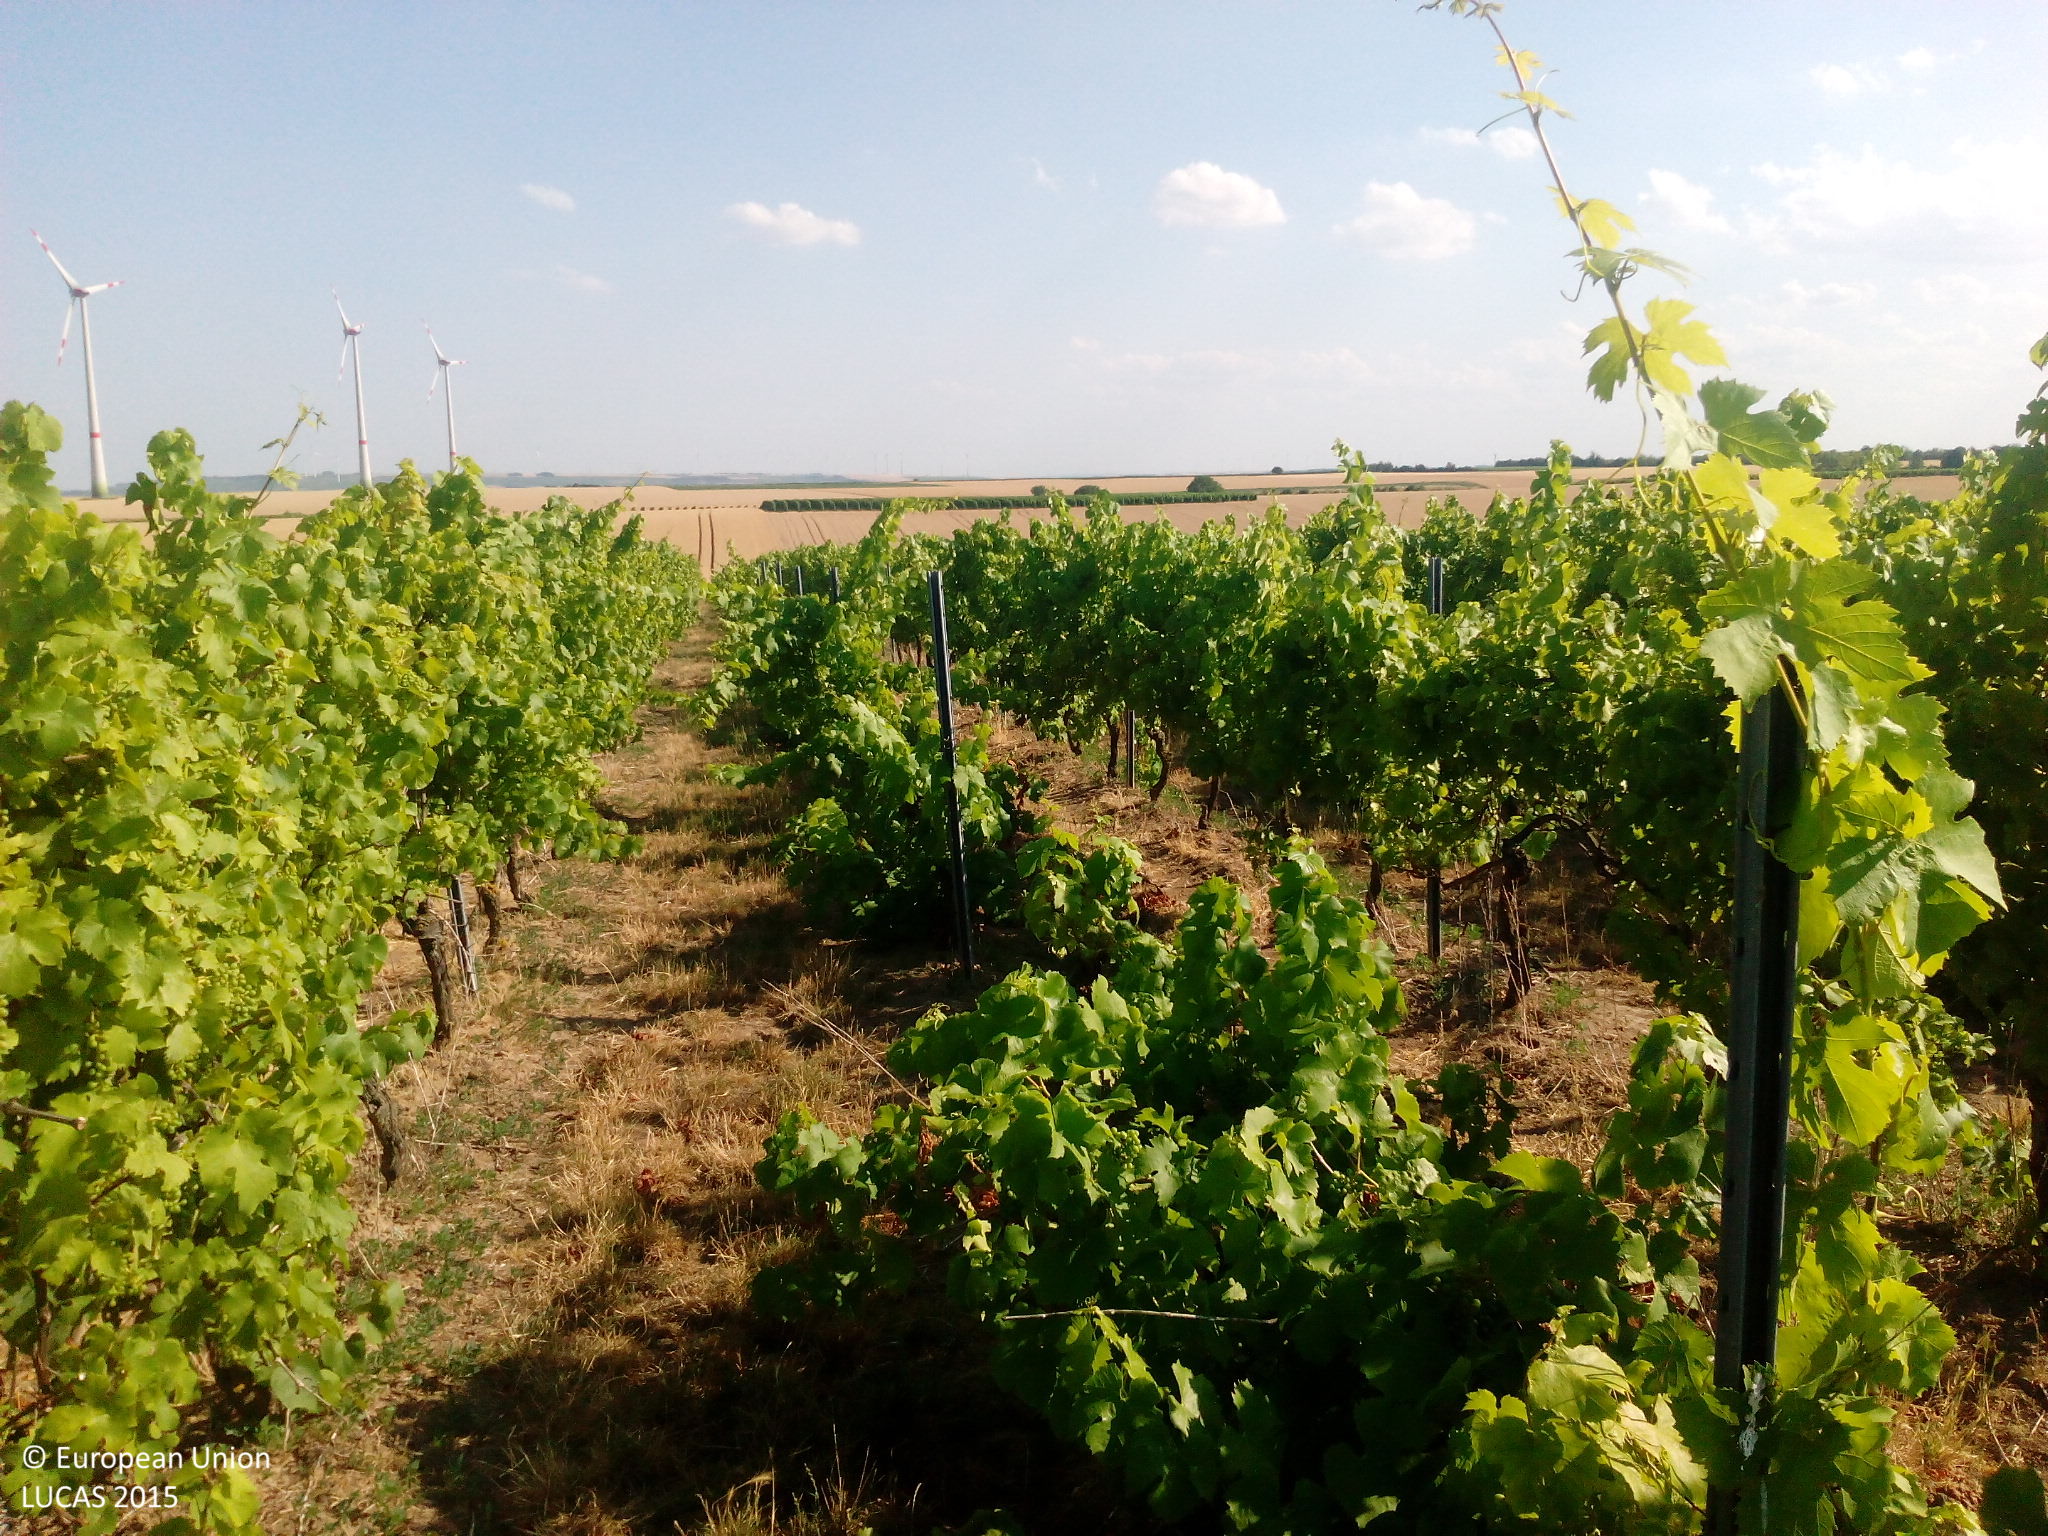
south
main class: Cropland
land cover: Vineyards
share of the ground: > 75 %
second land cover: Grassland without tree/shrub cover
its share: 50 - 75 %
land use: Agriculture (excluding fallow land and kitchen gardens)
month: July
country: DE
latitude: 49.8275
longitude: 8.1516
